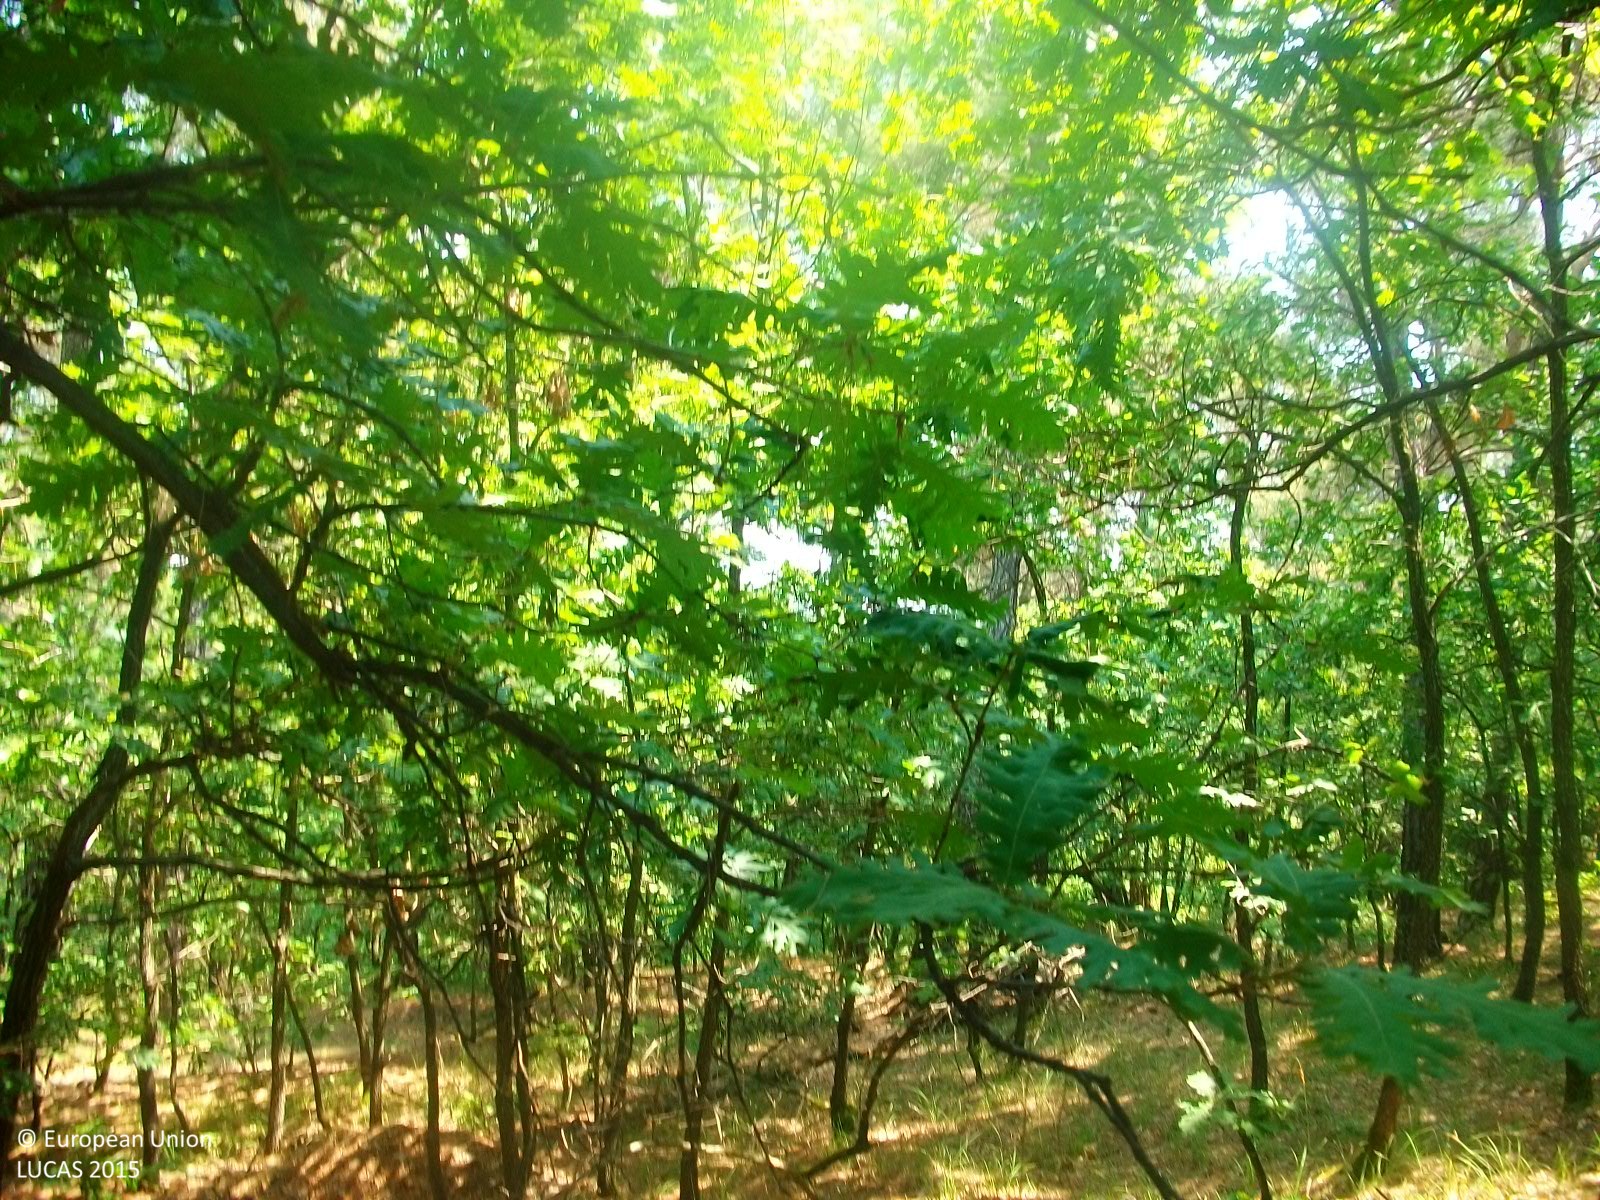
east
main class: Woodland
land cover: Broadleaved woodland
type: thermophilous deciduous forest
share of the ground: > 75 %
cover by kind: broadleaved forest trees 100 %
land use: Forestry
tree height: > 5 m
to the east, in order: Broadleaved woodland
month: July
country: GR
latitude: 41.1712
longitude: 26.2186
